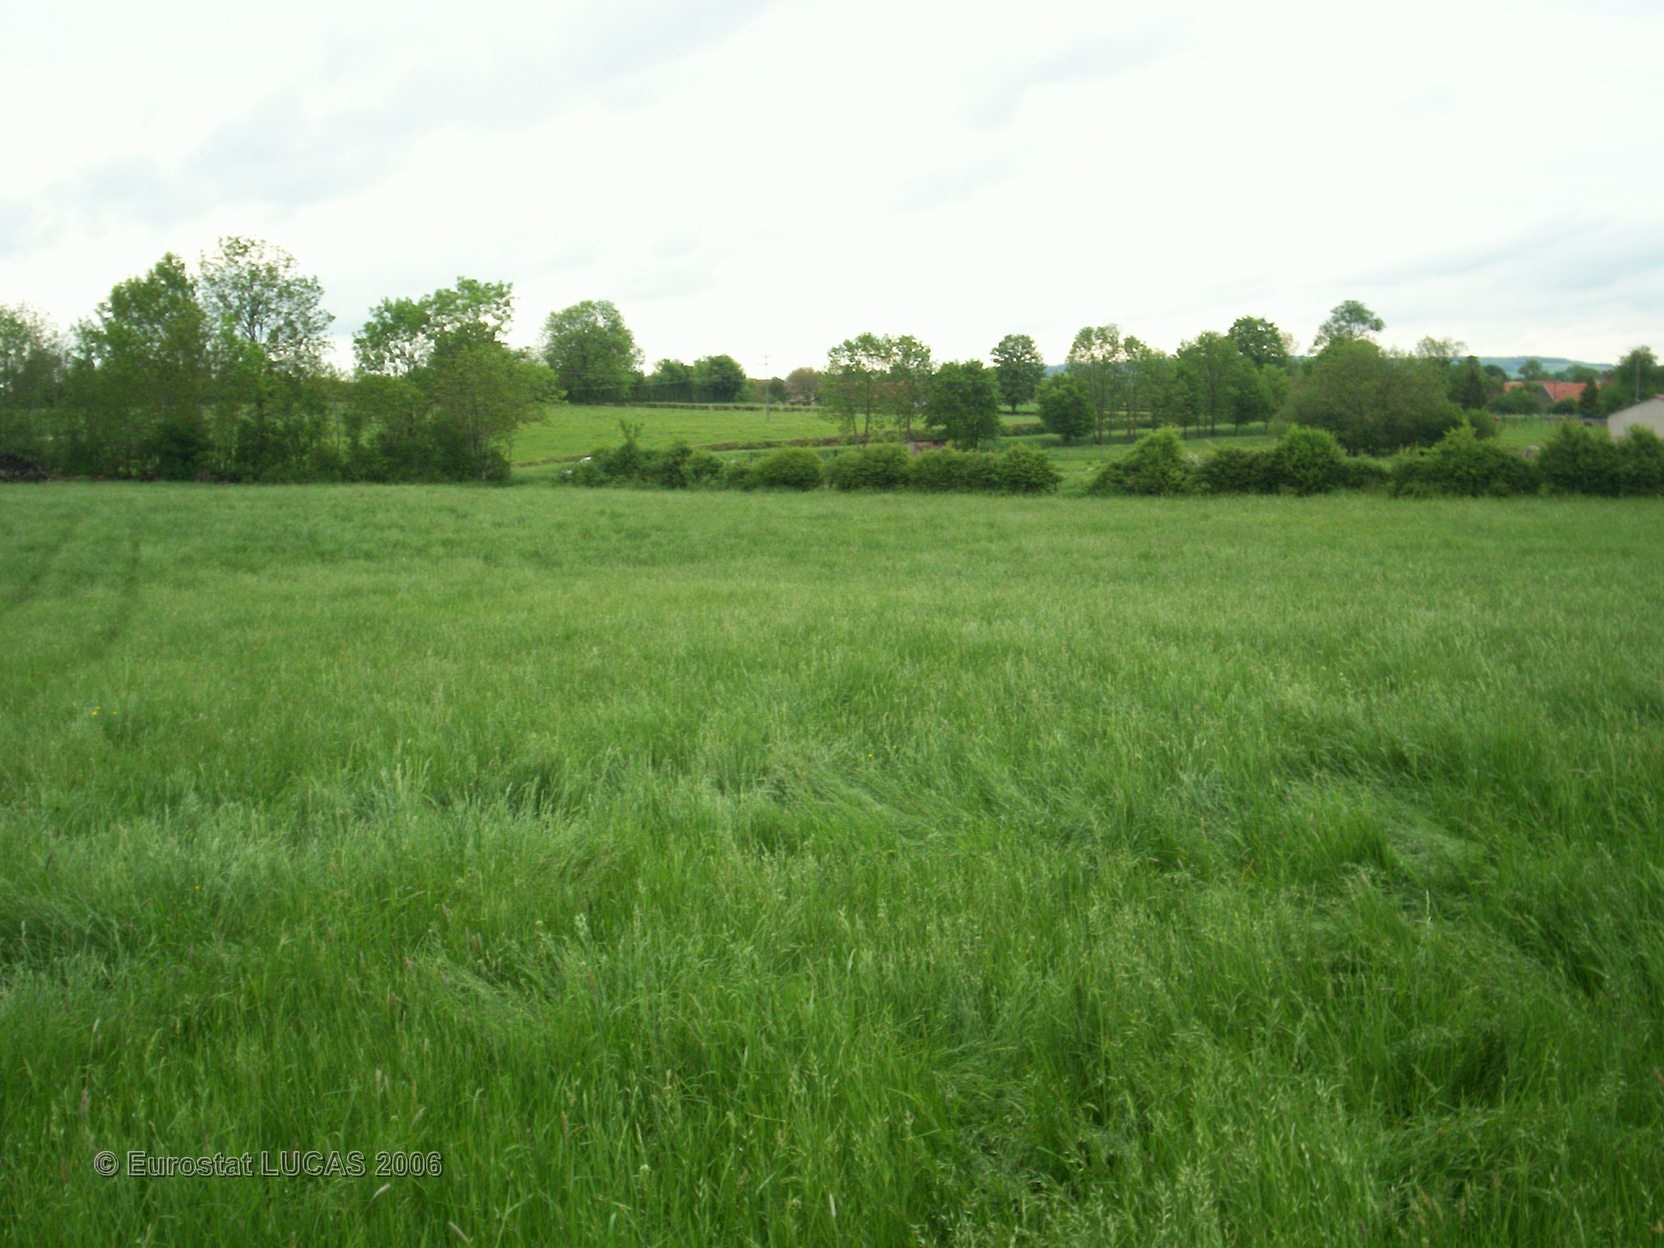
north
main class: Grassland
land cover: Grassland without tree/shrub cover
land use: Agriculture (excluding fallow land and kitchen gardens)
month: May
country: FR
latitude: 47.2061
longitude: 4.5739
